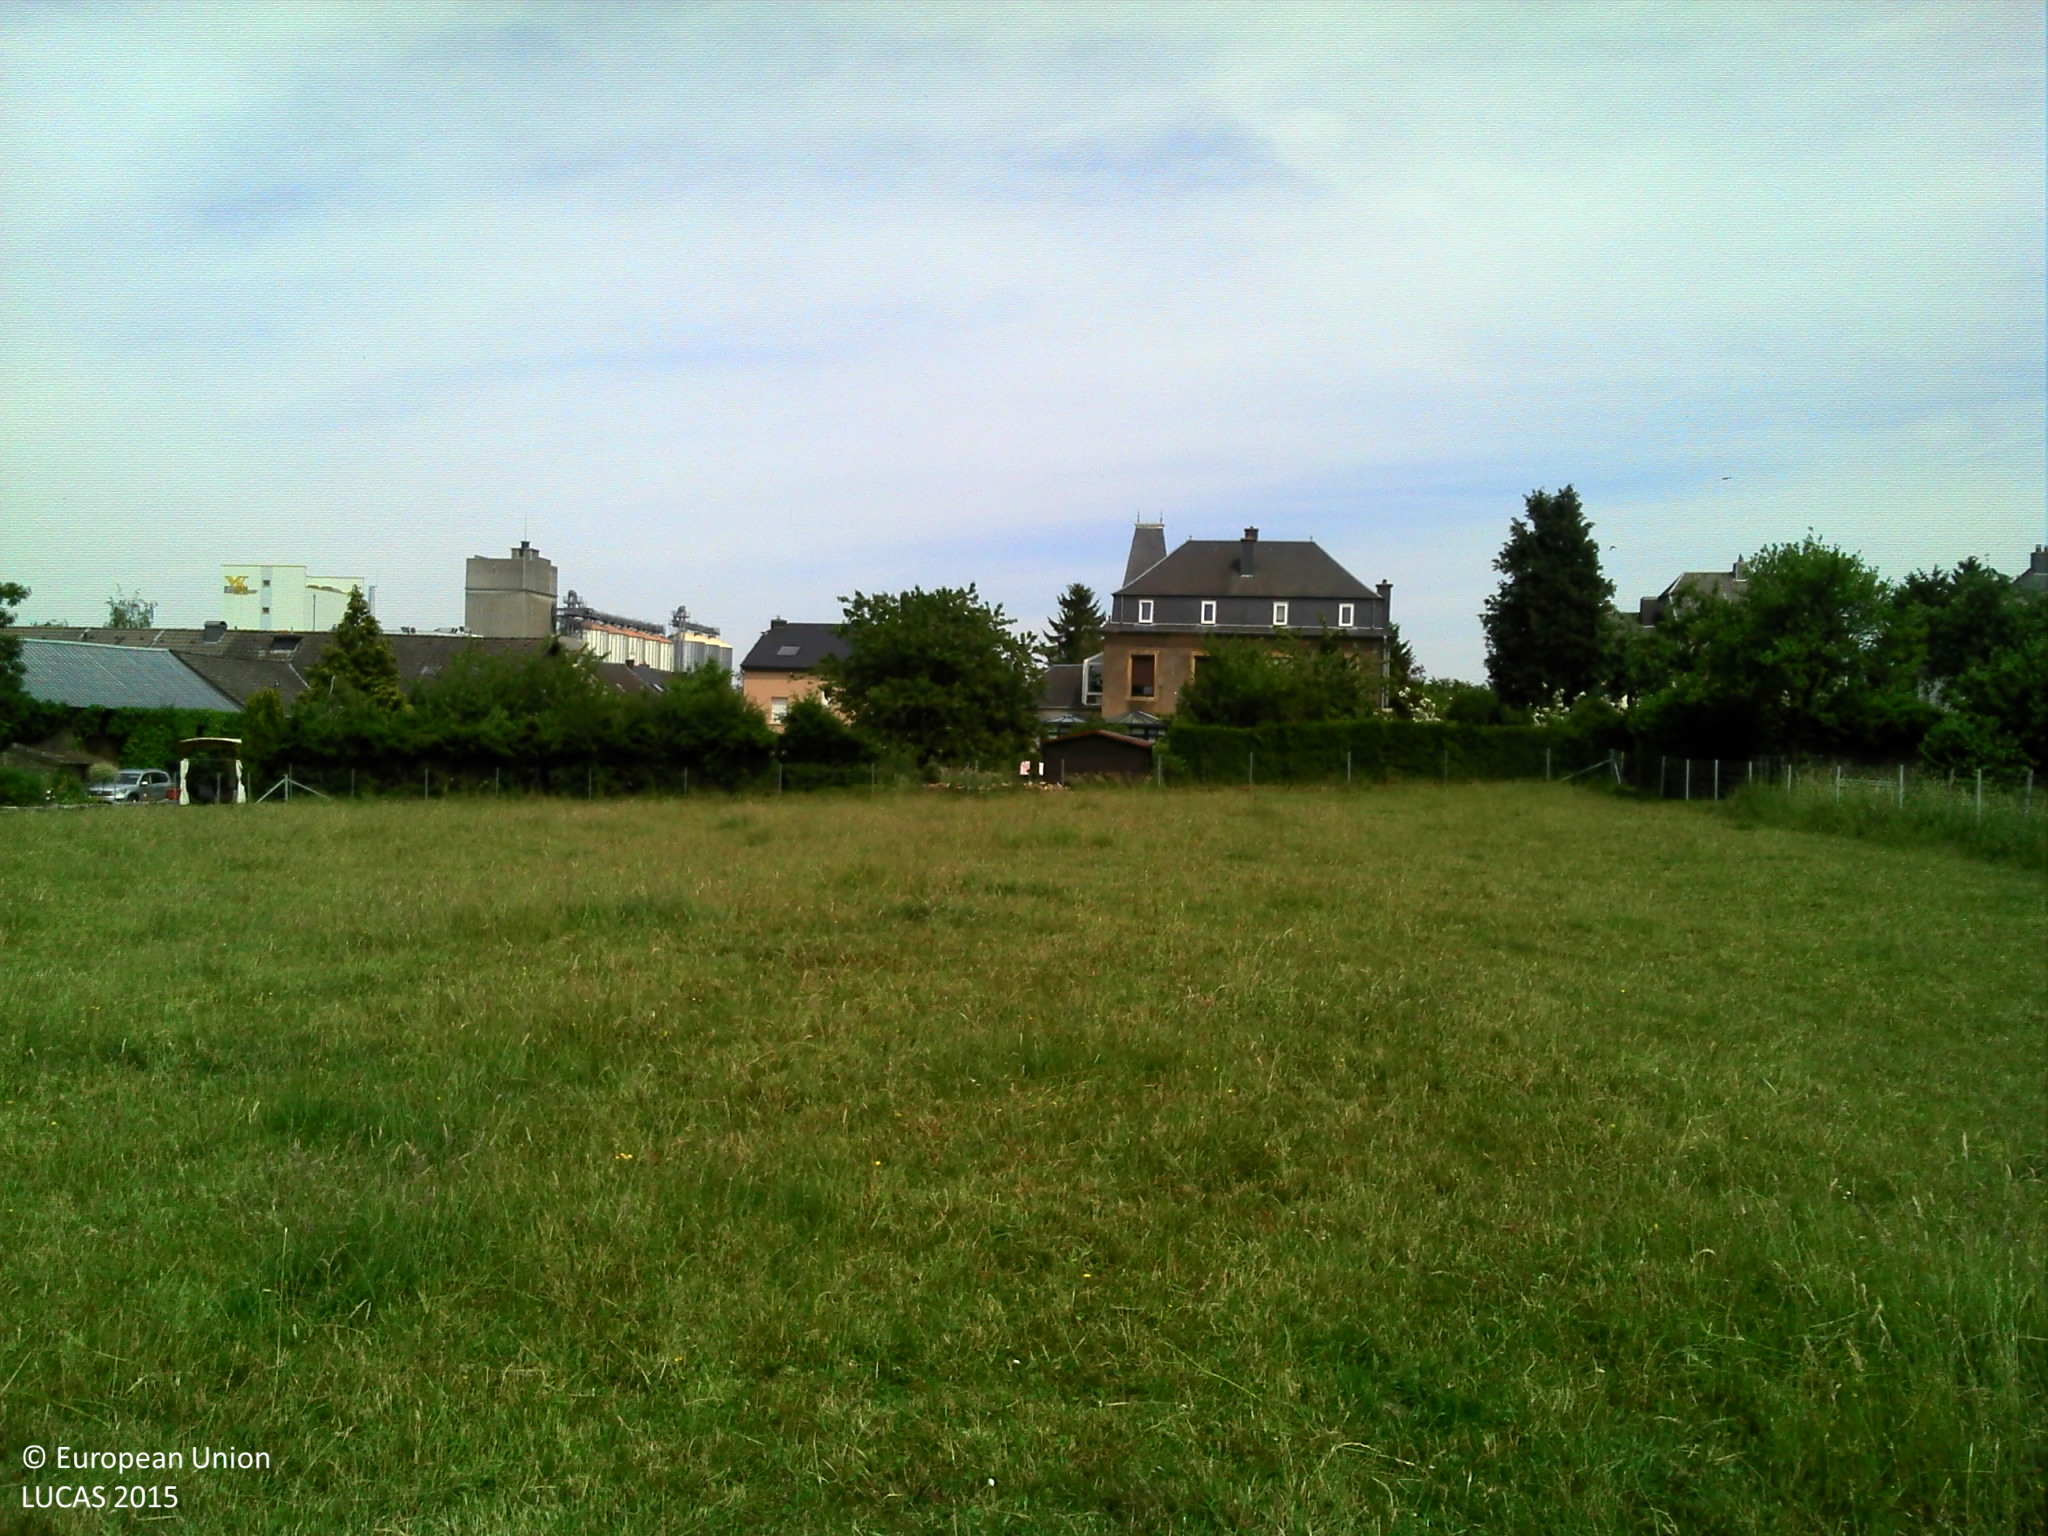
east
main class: Grassland
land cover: Grassland without tree/shrub cover
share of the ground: > 75 %
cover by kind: herbaceous plants 100 %
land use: Agriculture (excluding fallow land and kitchen gardens)
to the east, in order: Grassland without tree/shrub cover; Artificial constructions in urban areas; Spruce dominated mixed woodland; Grassland without tree/shrub cover
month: June
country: LU
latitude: 49.6429
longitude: 5.9138
